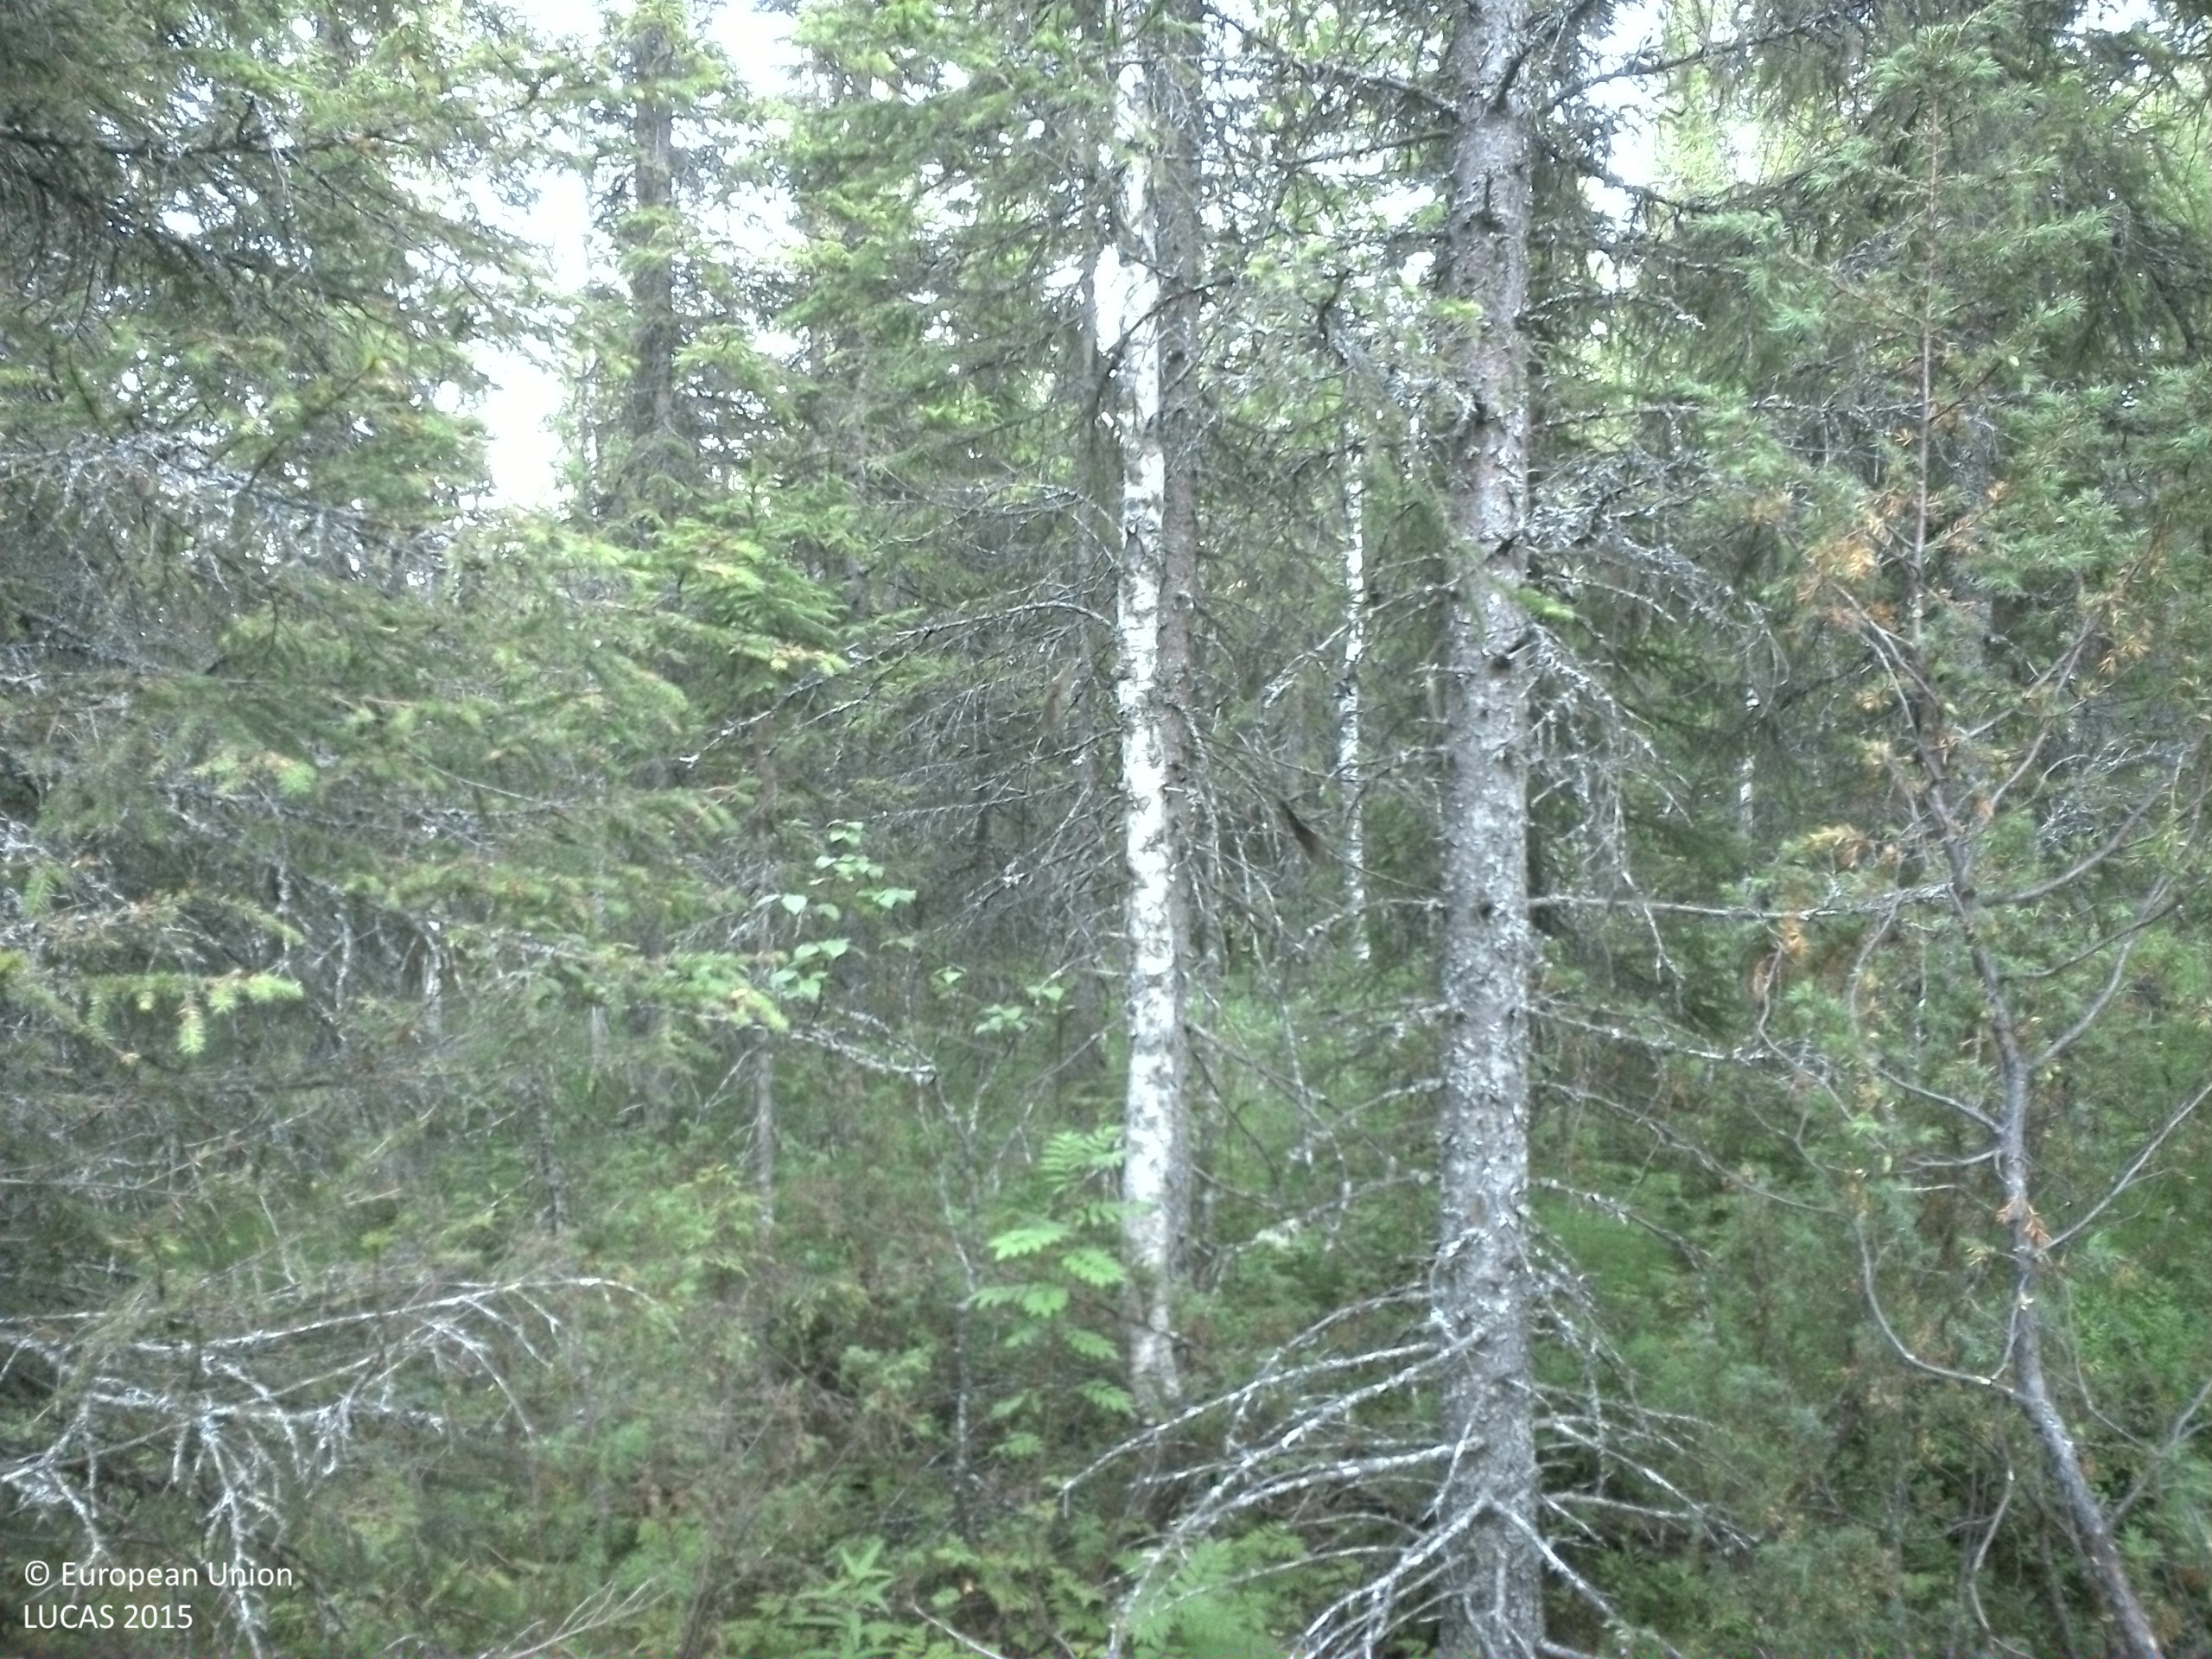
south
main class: Woodland
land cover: Spruce dominated mixed woodland
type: boreal forest
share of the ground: > 75 %
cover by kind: coniferous forest trees 45 %, shrubs 25 %, broadleaved forest trees 20 %, herbaceous plants 10 %
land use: Forestry
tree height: > 5 m
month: August
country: SE
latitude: 63.8212
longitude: 17.8753
